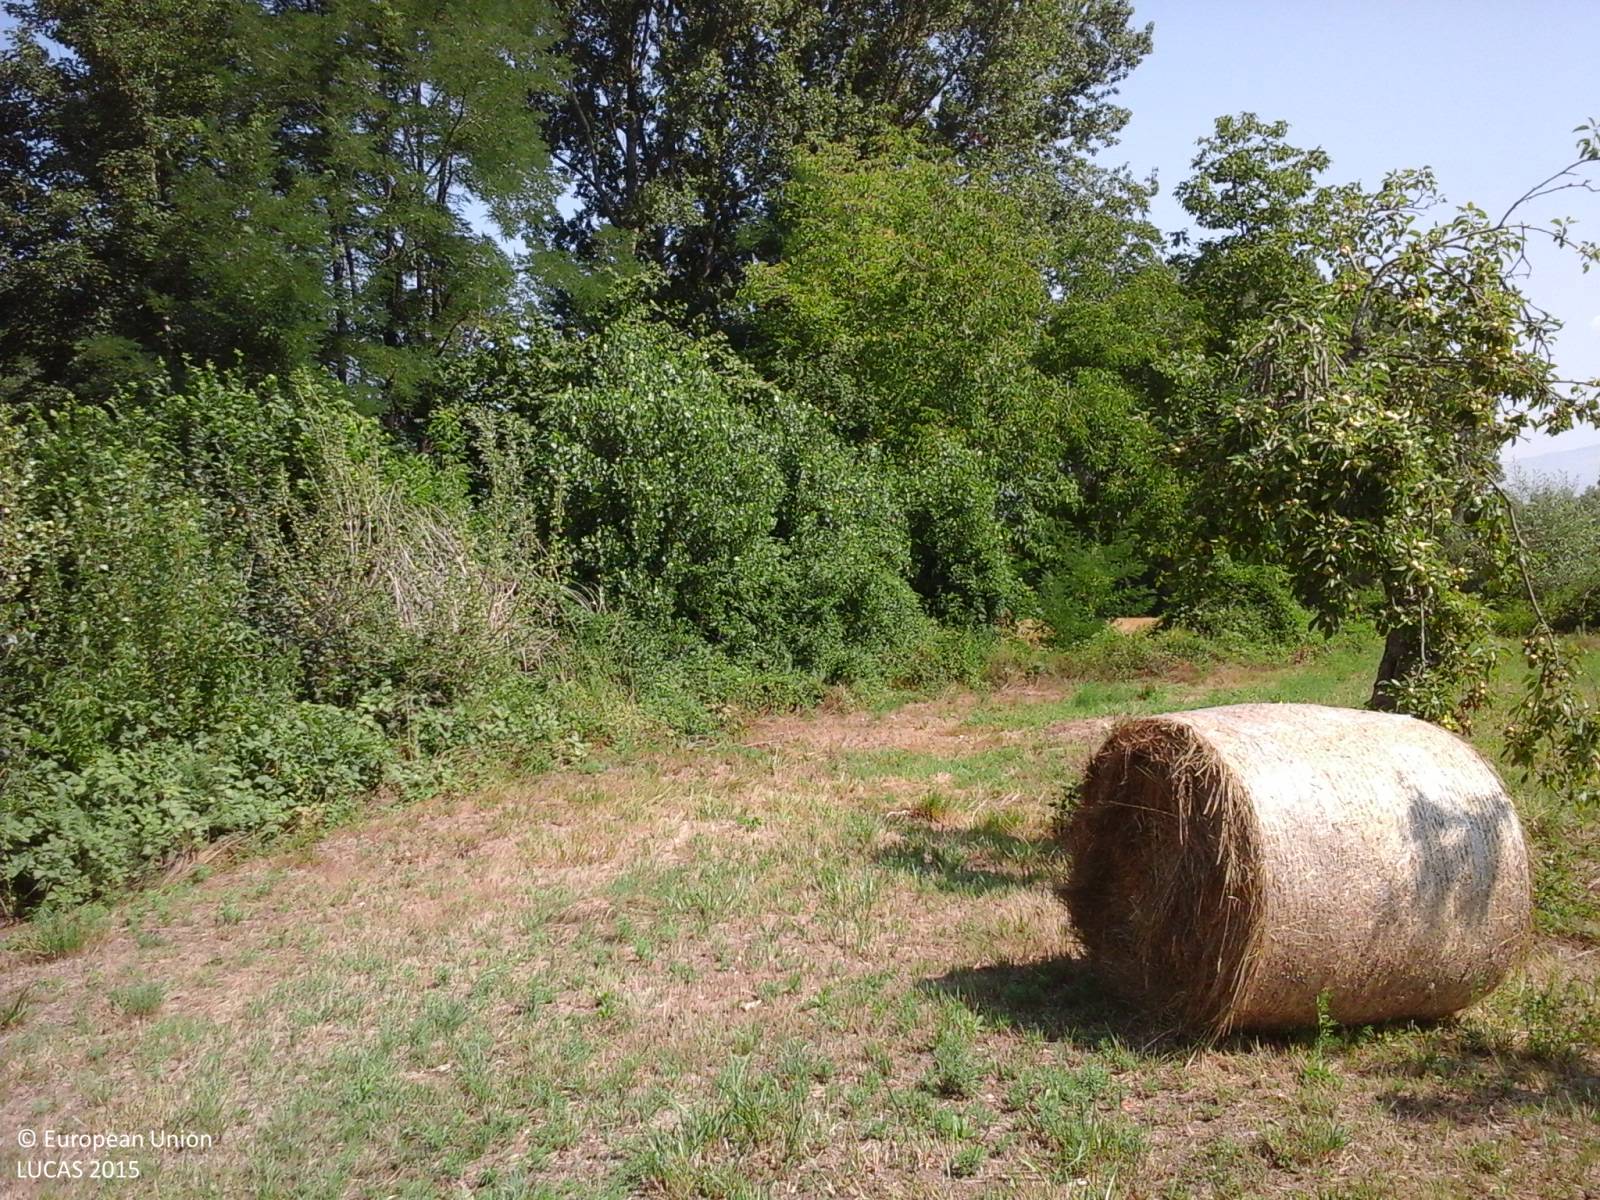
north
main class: Cropland
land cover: Mixed cereals for fodder
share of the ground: > 75 %
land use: Agriculture (excluding fallow land and kitchen gardens)
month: July
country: IT
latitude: 42.3298
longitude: 13.2781
